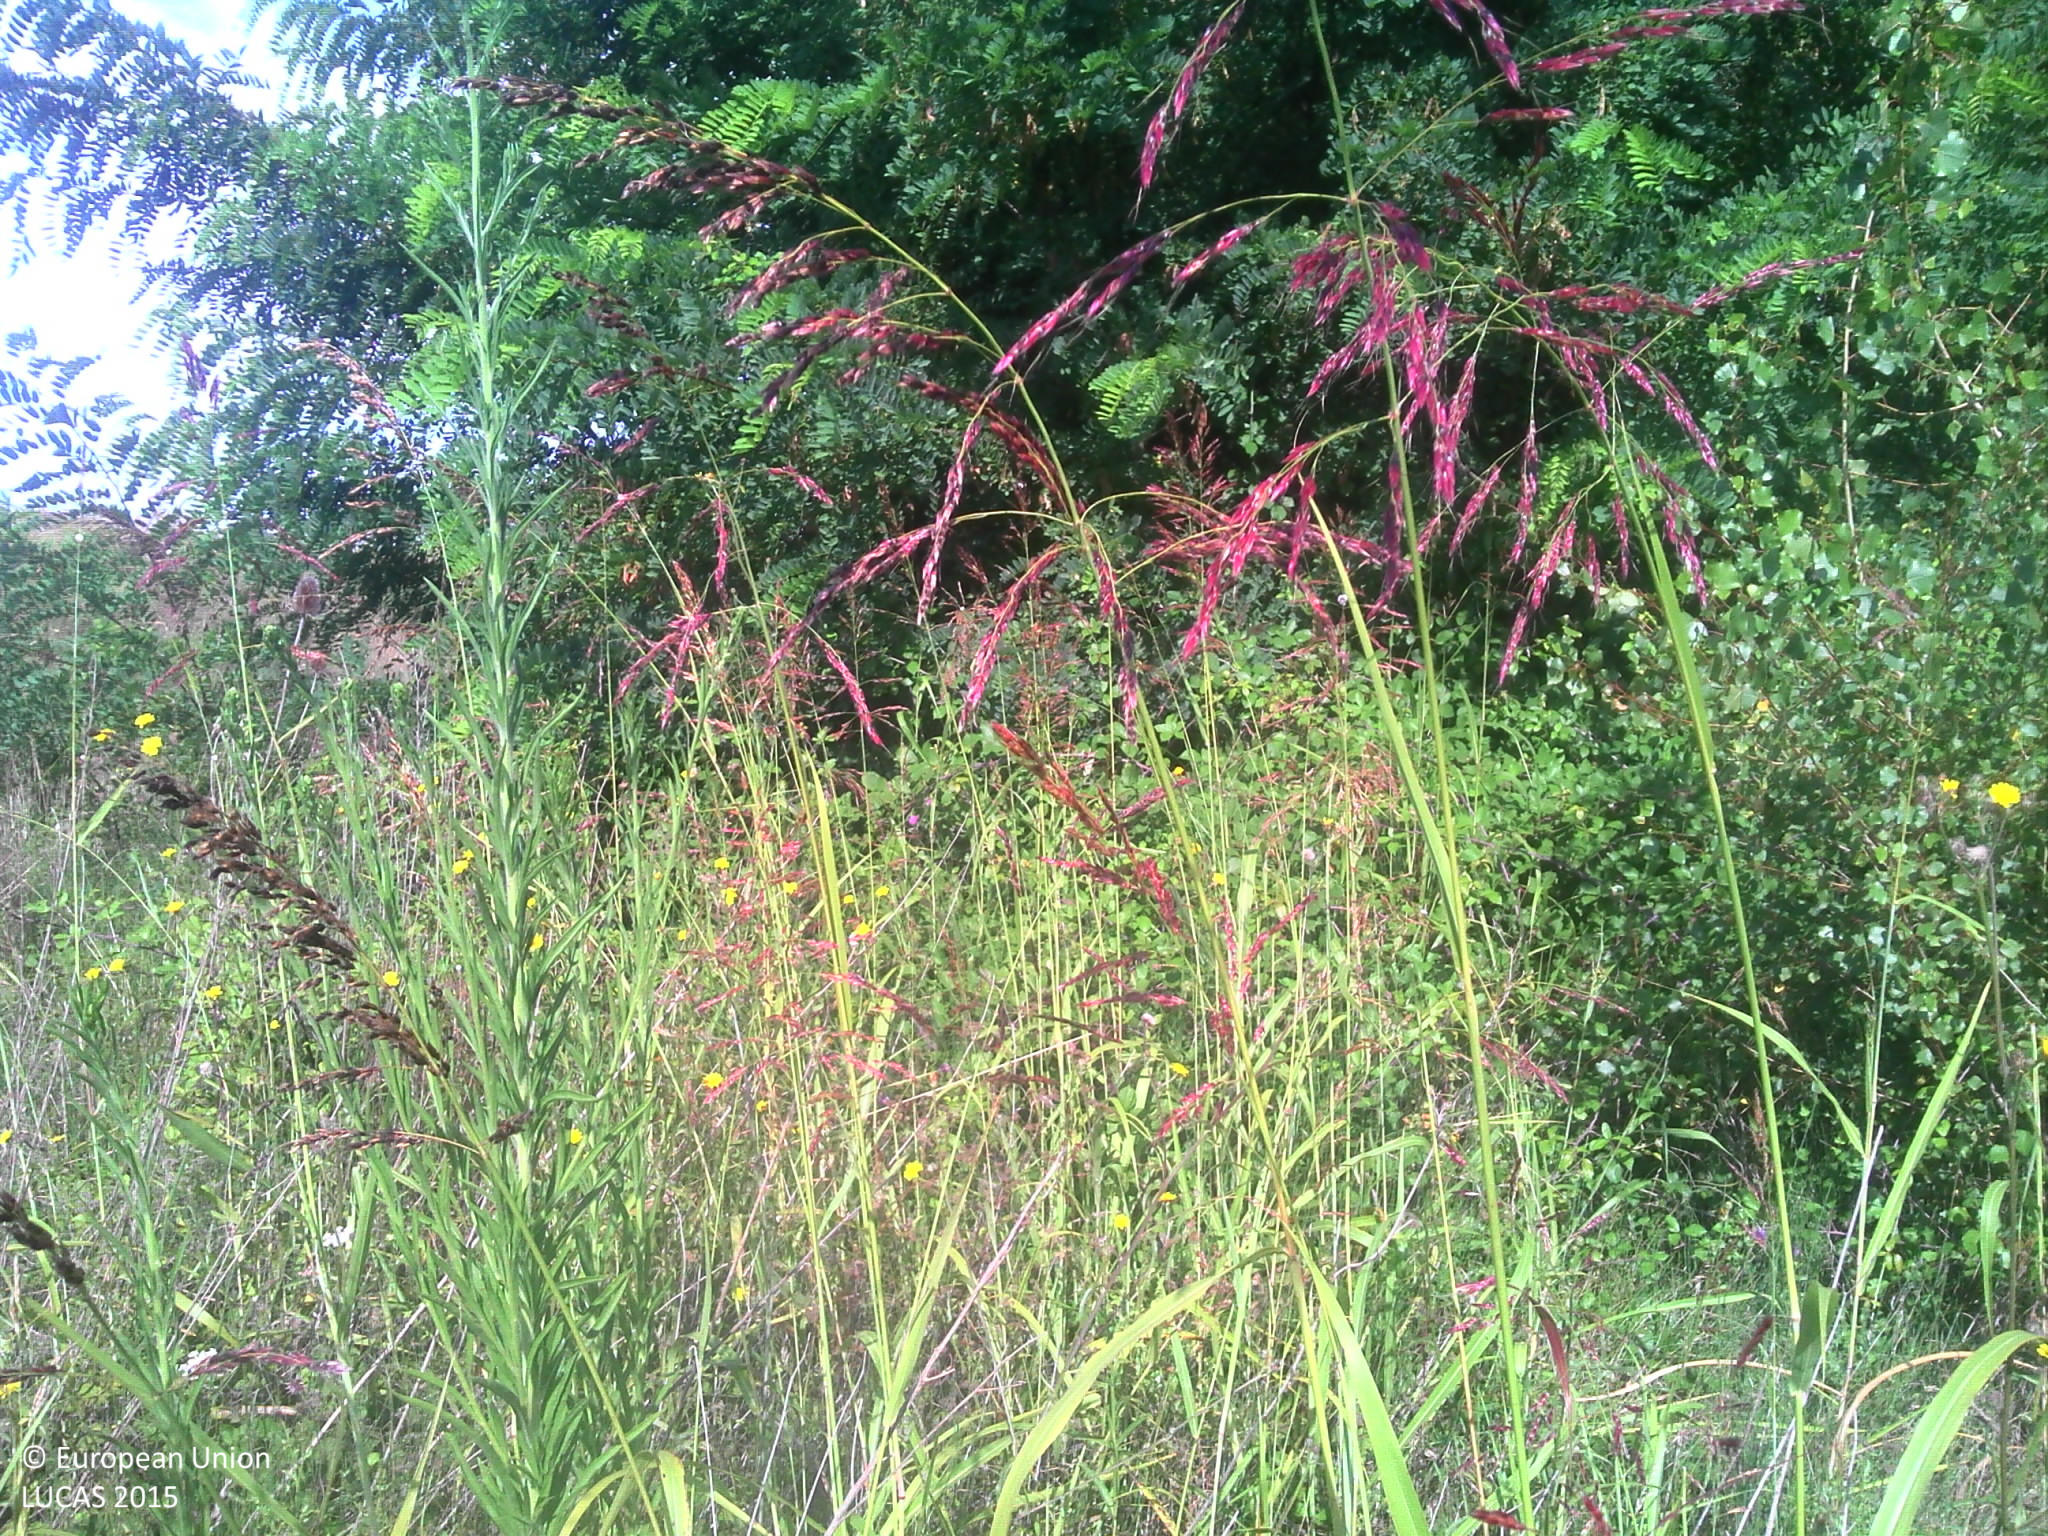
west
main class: Grassland
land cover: Grassland with sparse tree/shrub cover
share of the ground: > 75 %
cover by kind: herbaceous plants 85 %, broadleaved forest trees 5 %, shrubs 5 %, consolidated bare surface 5 %
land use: Fallow land
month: July
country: FR
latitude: 43.7372
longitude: 5.2786
